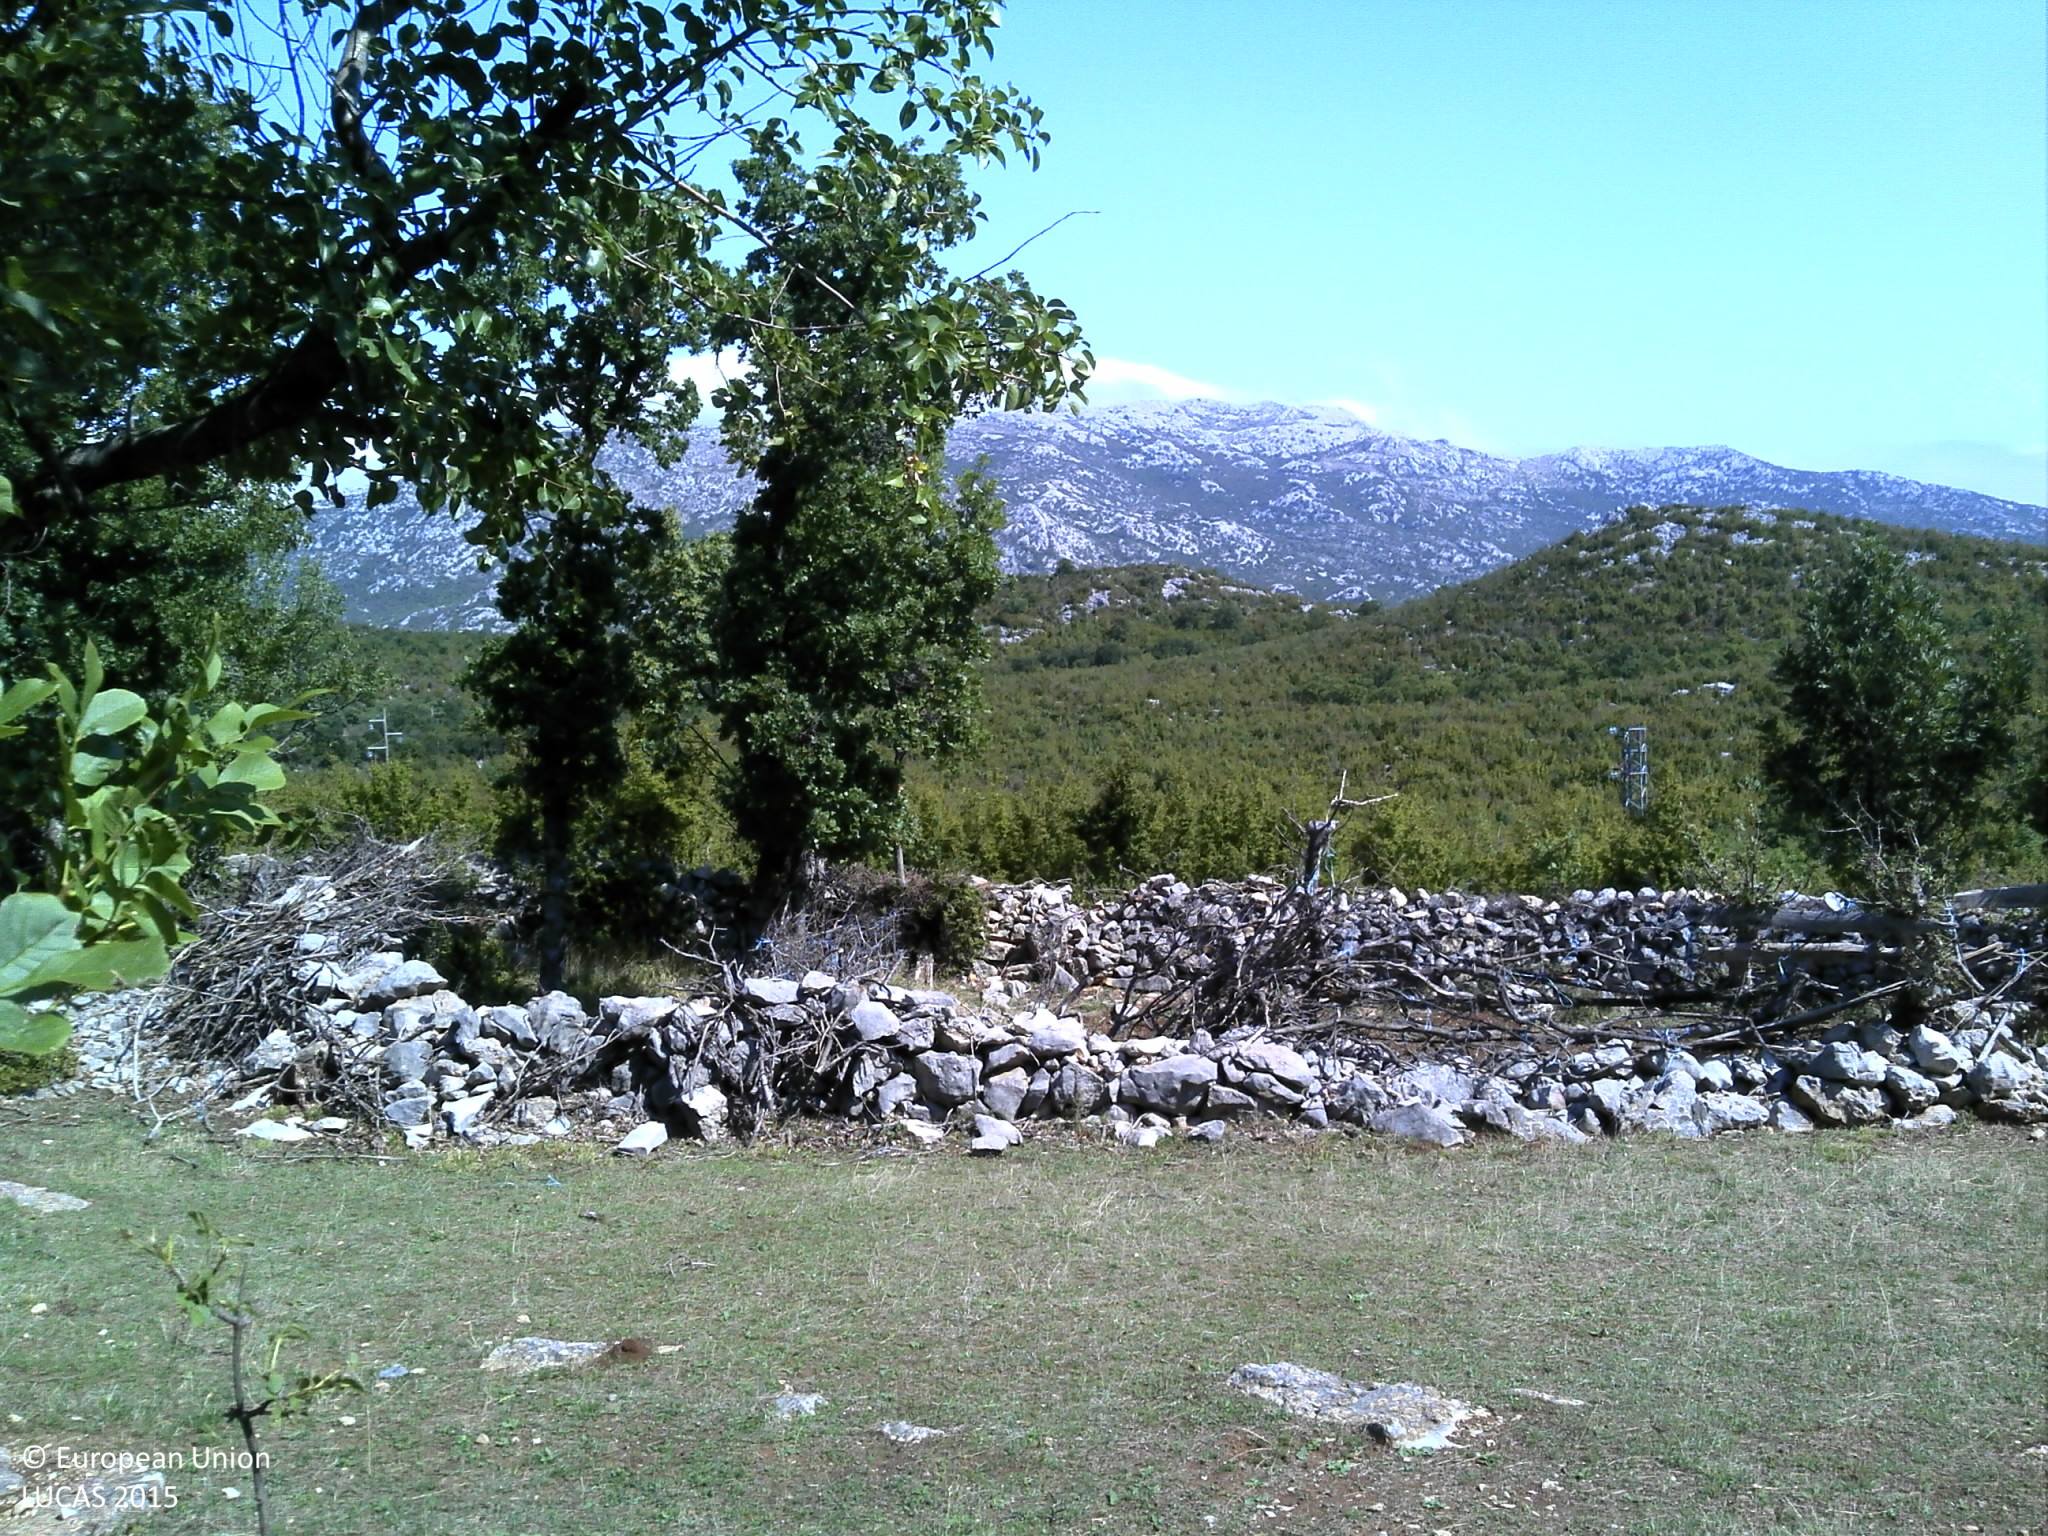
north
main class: Grassland
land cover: Grassland with sparse tree/shrub cover
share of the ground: 50 - 75 %
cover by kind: herbaceous plants 75 %, shrubs 10 %, broadleaved forest trees 5 %, consolidated bare surface 5 %, unconsolidated bare surface 5 %
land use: Agriculture (excluding fallow land and kitchen gardens)
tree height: > 5 m
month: August
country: HR
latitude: 44.2043
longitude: 15.8367
